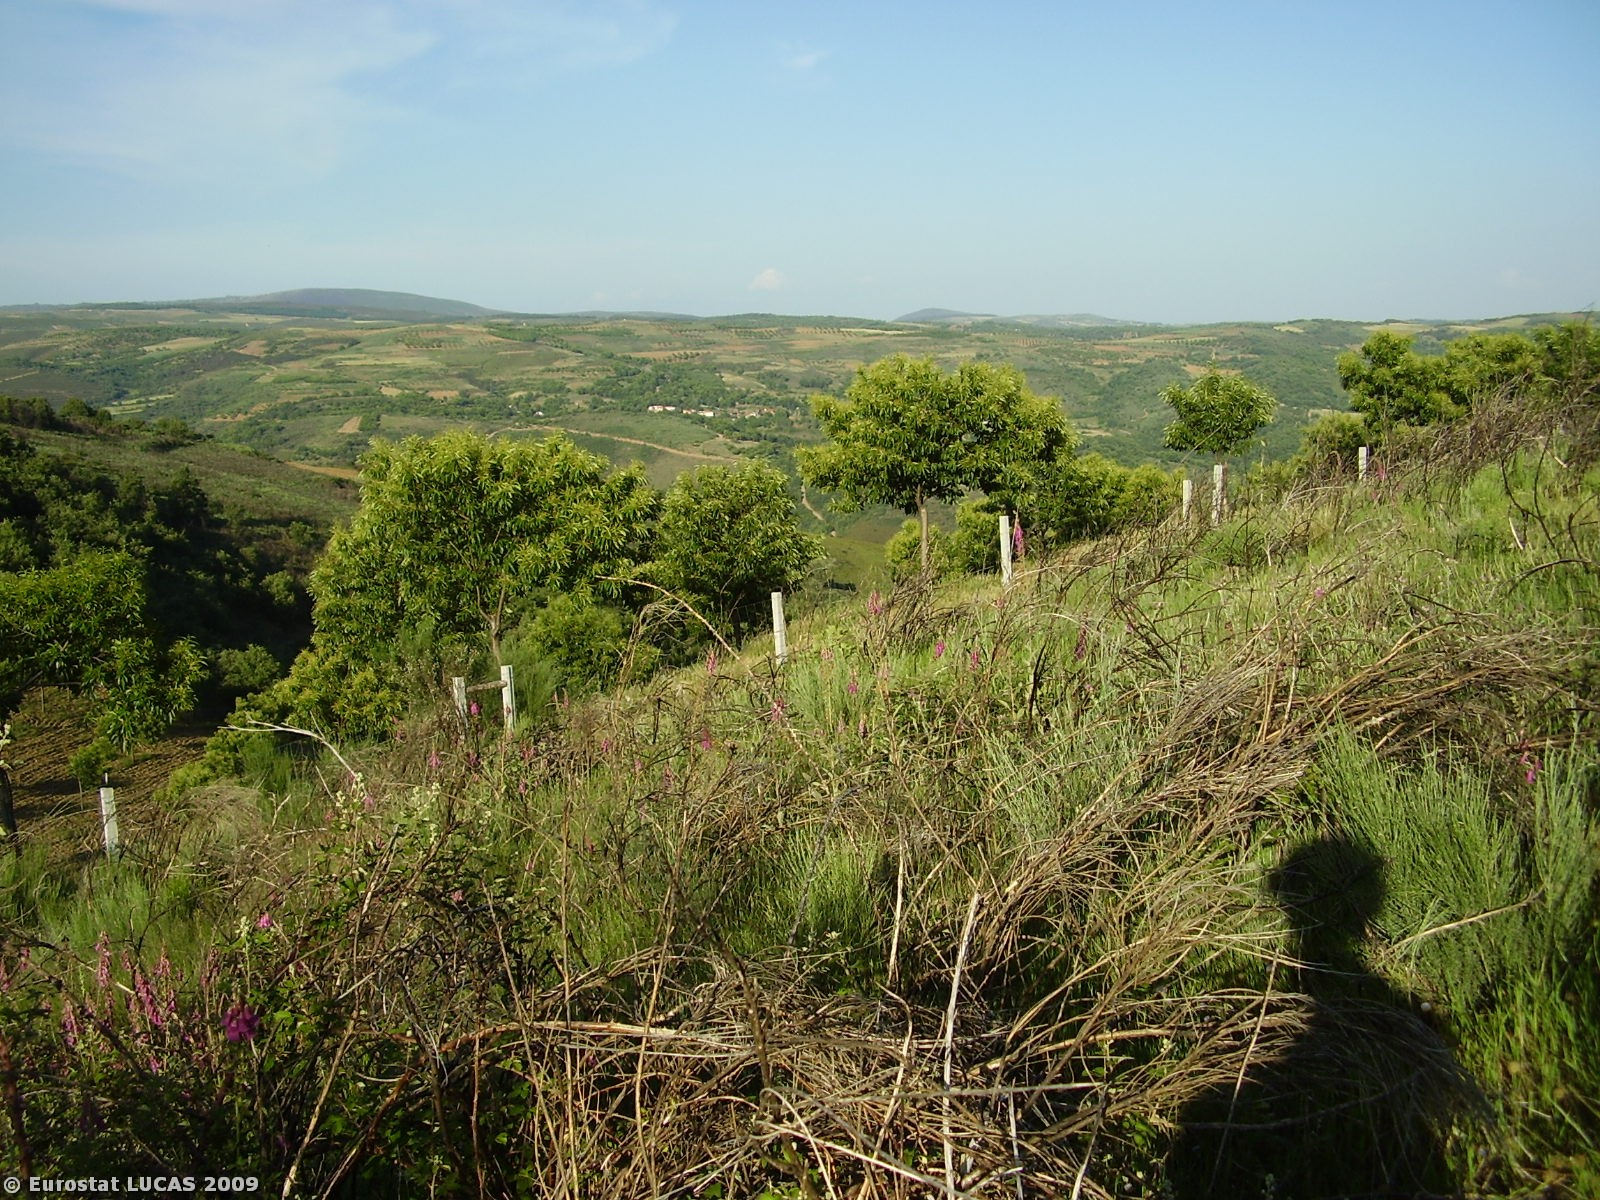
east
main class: Grassland
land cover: Spontaneously vegetated surfaces
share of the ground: > 75 %
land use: Nature reserves
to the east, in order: Spontaneously vegetated surfaces; Other structural elements; Tracks; Fences; Nuts trees; Other structural elements; Nuts trees; Other structural elements; Nuts trees; Other structural elements; Nuts trees; Other structural elements; Nuts trees; Other structural elements; Nuts trees; Other structural elements; Nuts trees; Other structural elements; Nuts trees; Other structural elements; Nuts trees; Other structural elements; Nuts trees; Other structural elements; Tracks; Other structural elements; Nuts trees; Other structural elements; Nuts trees; Other structural elements; Nuts trees; Other structural elements; Nuts trees; Other structural elements; Nuts trees; Other structural elements; Nuts trees; Fences; Shrubland with sparse tree cover
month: June
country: PT
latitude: 41.9108
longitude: -6.9619
